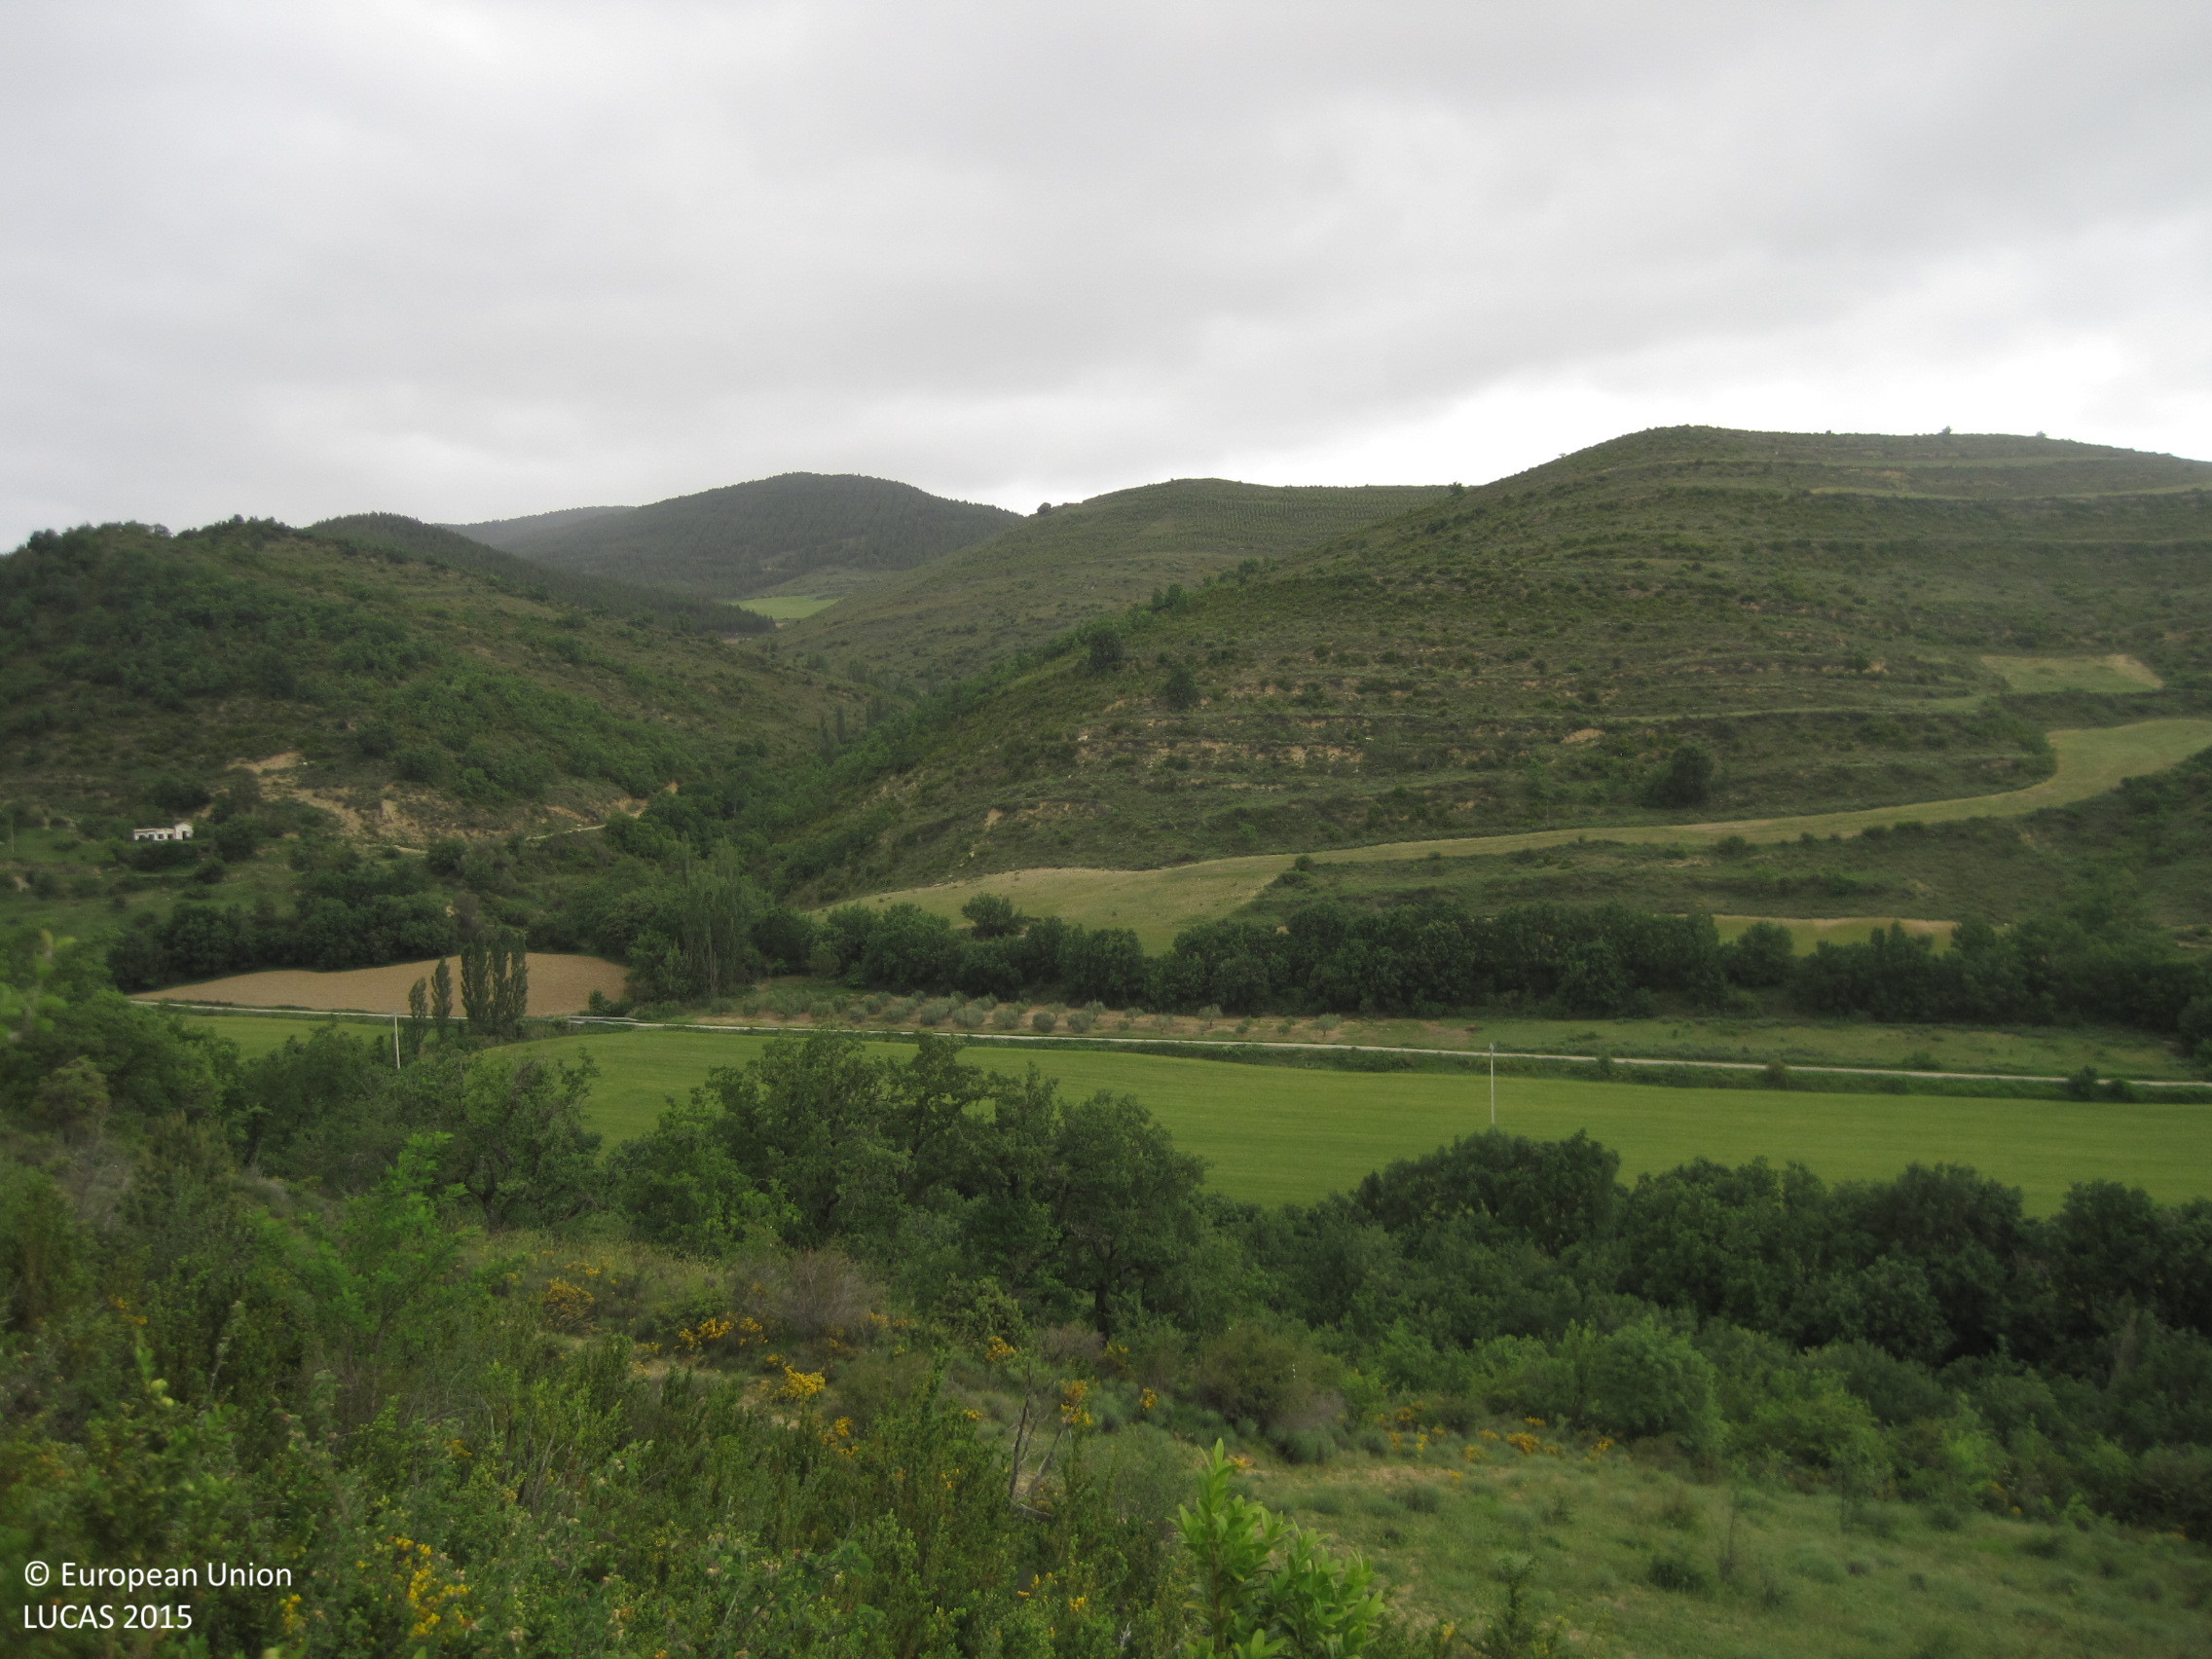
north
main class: Shrubland
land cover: Shrubland without tree cover
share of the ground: > 75 %
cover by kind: shrubs 95 %, herbaceous plants 5 %
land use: Semi-natural and natural areas not in use
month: May
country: ES
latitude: 42.5880
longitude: -1.4285
